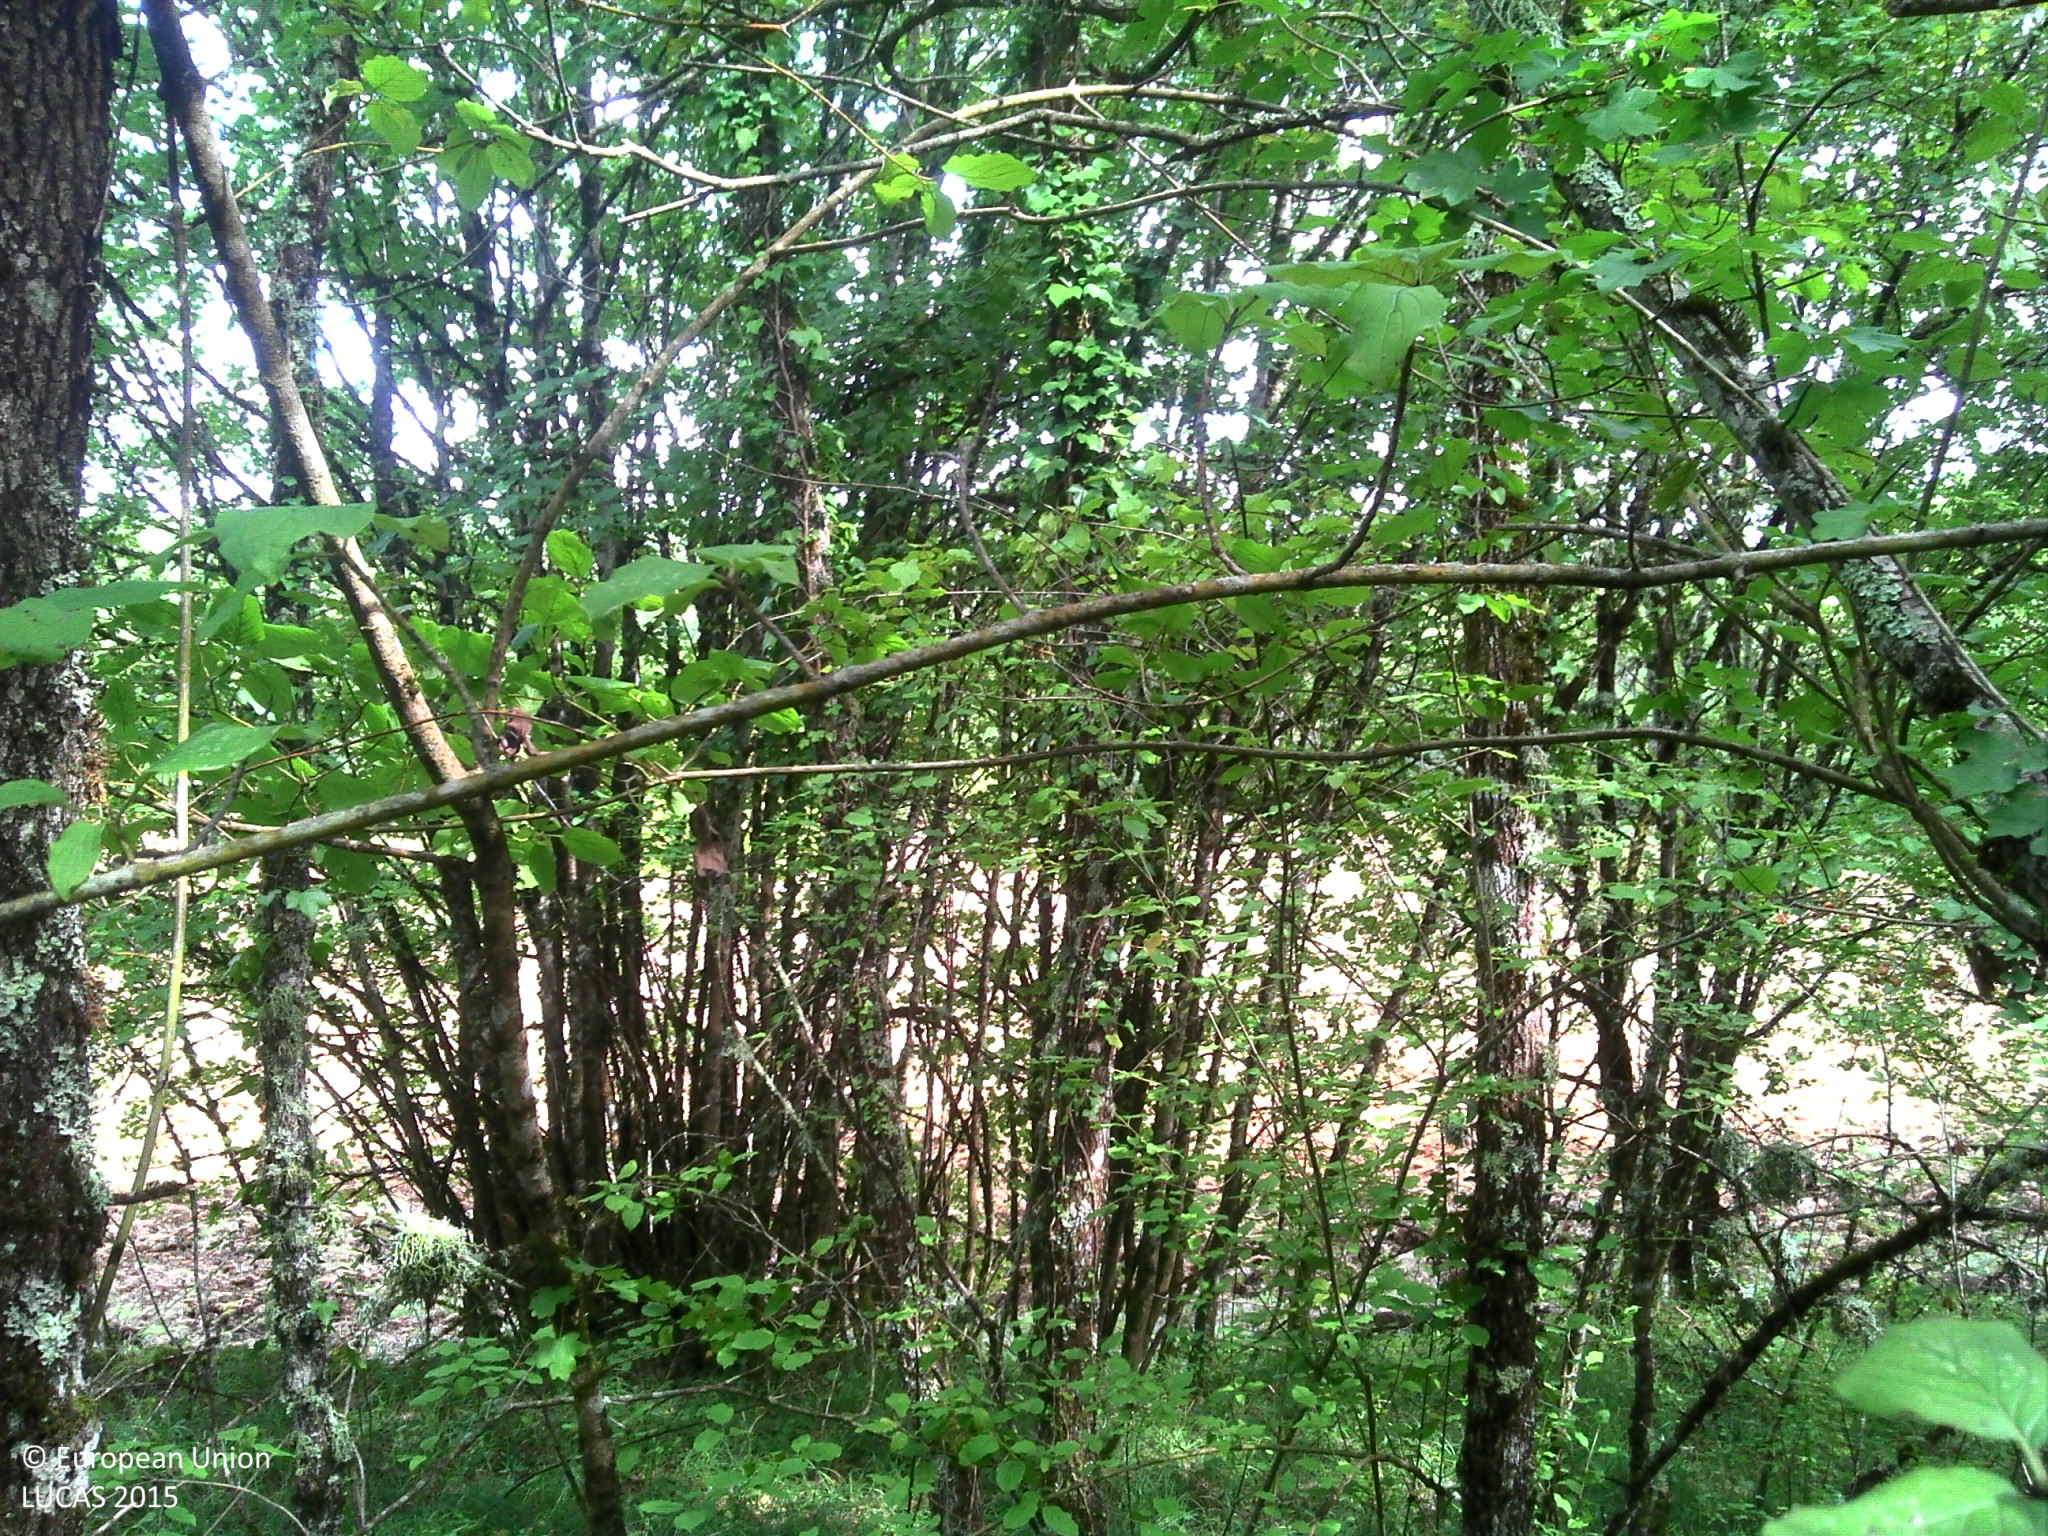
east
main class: Woodland
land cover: Broadleaved woodland
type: thermophilous deciduous forest
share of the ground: > 75 %
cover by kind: broadleaved forest trees 60 %, shrubs 30 %, herbaceous plants 5 %, lichens and mosses 5 %
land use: Agriculture (excluding fallow land and kitchen gardens)
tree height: > 5 m
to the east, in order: Broadleaved woodland; Dry stone walls; Grass margins; Other bare soil; Nuts trees; Other bare soil; Abandoned hedges; Dry stone walls; Grass margins; Other bare soil
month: September
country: FR
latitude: 44.5803
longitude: 1.2688
